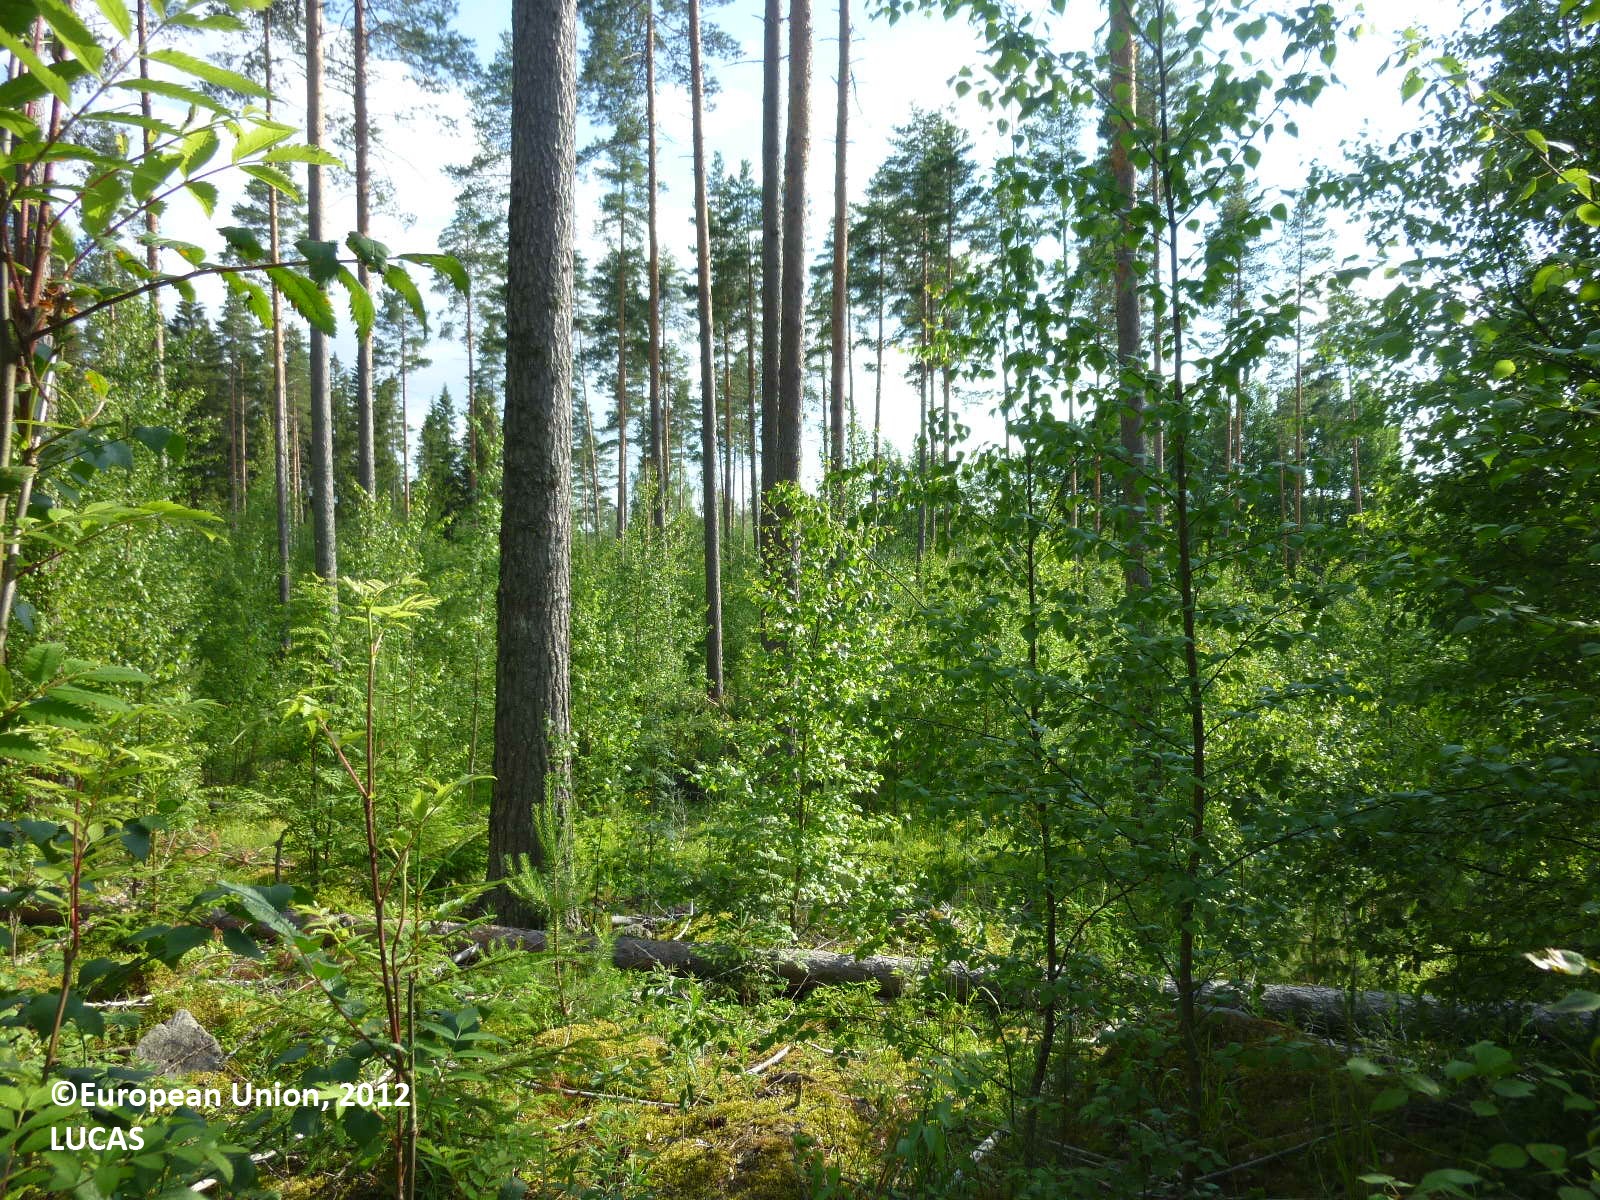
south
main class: Woodland
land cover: Pine dominated mixed woodland
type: boreal forest
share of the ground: 50 - 75 %
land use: Forestry
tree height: > 5 m
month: July
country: FI
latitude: 61.3878
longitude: 22.3609
